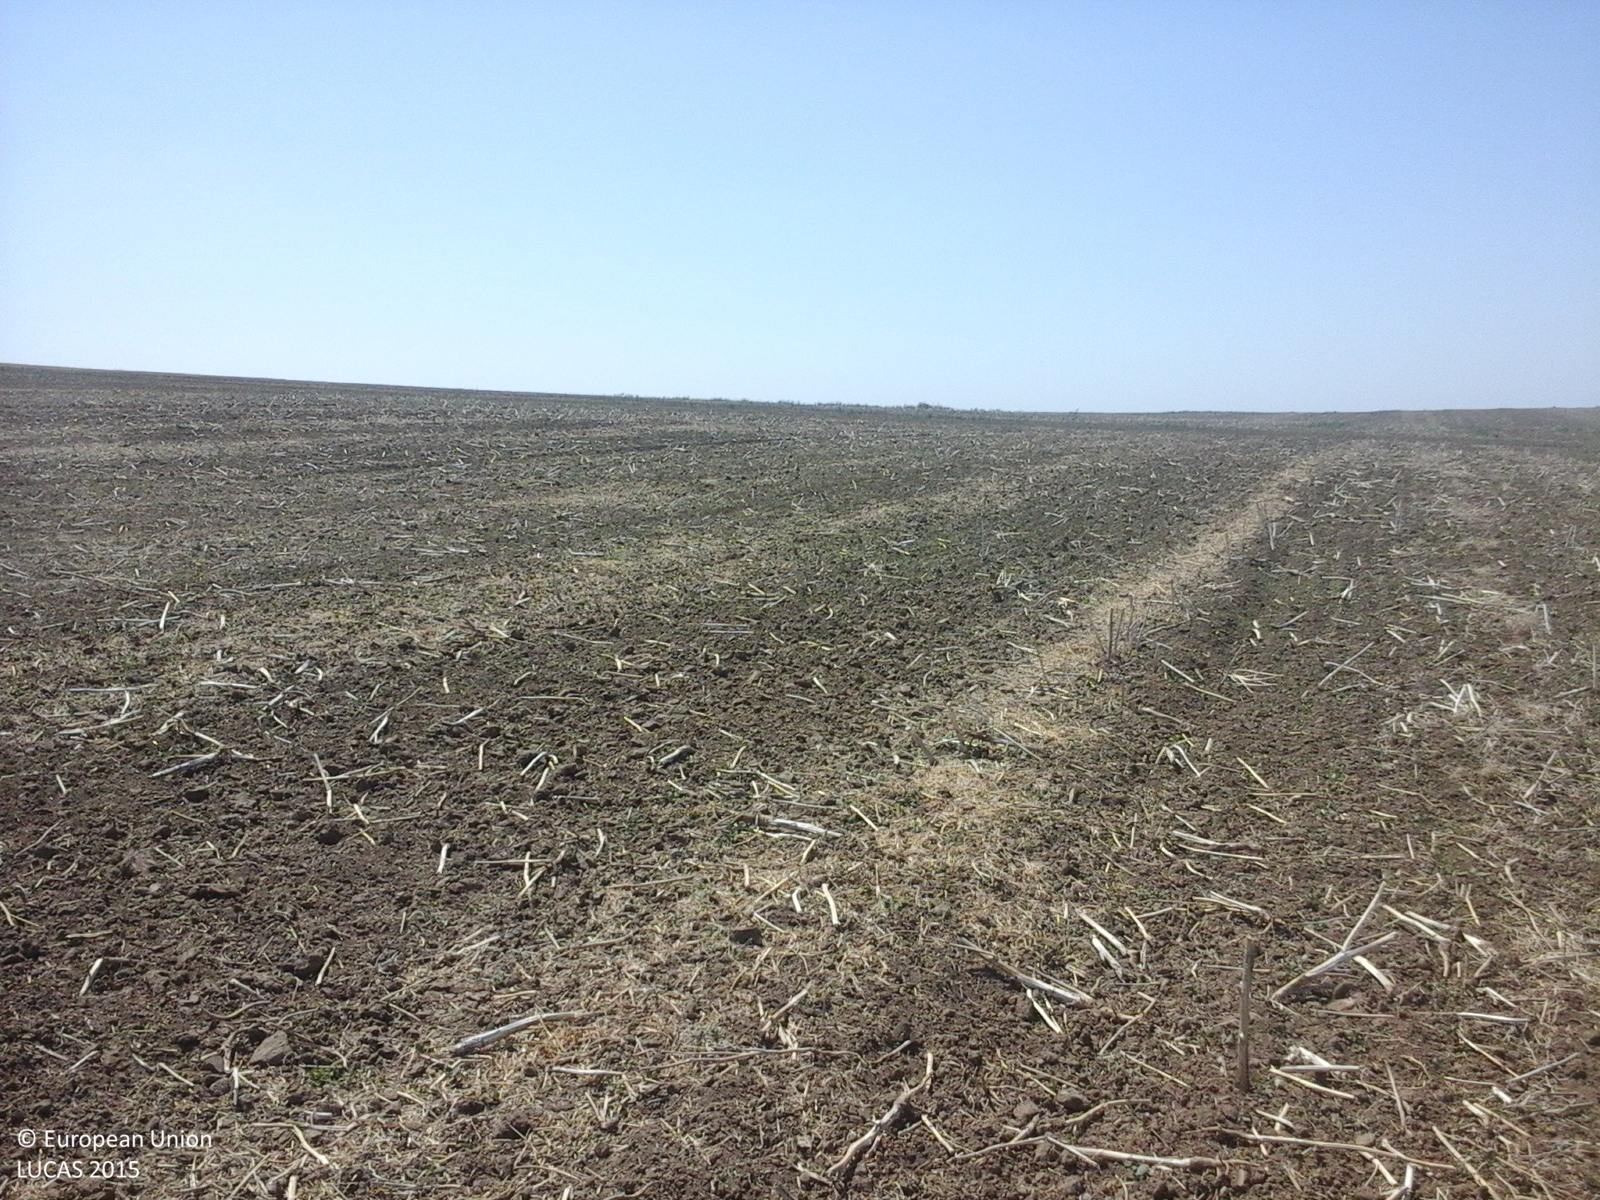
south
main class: Cropland
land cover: Rape and turnip rape
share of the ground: < 10 %
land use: Agriculture (excluding fallow land and kitchen gardens)
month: August
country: RO
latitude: 44.5898
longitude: 28.1902
